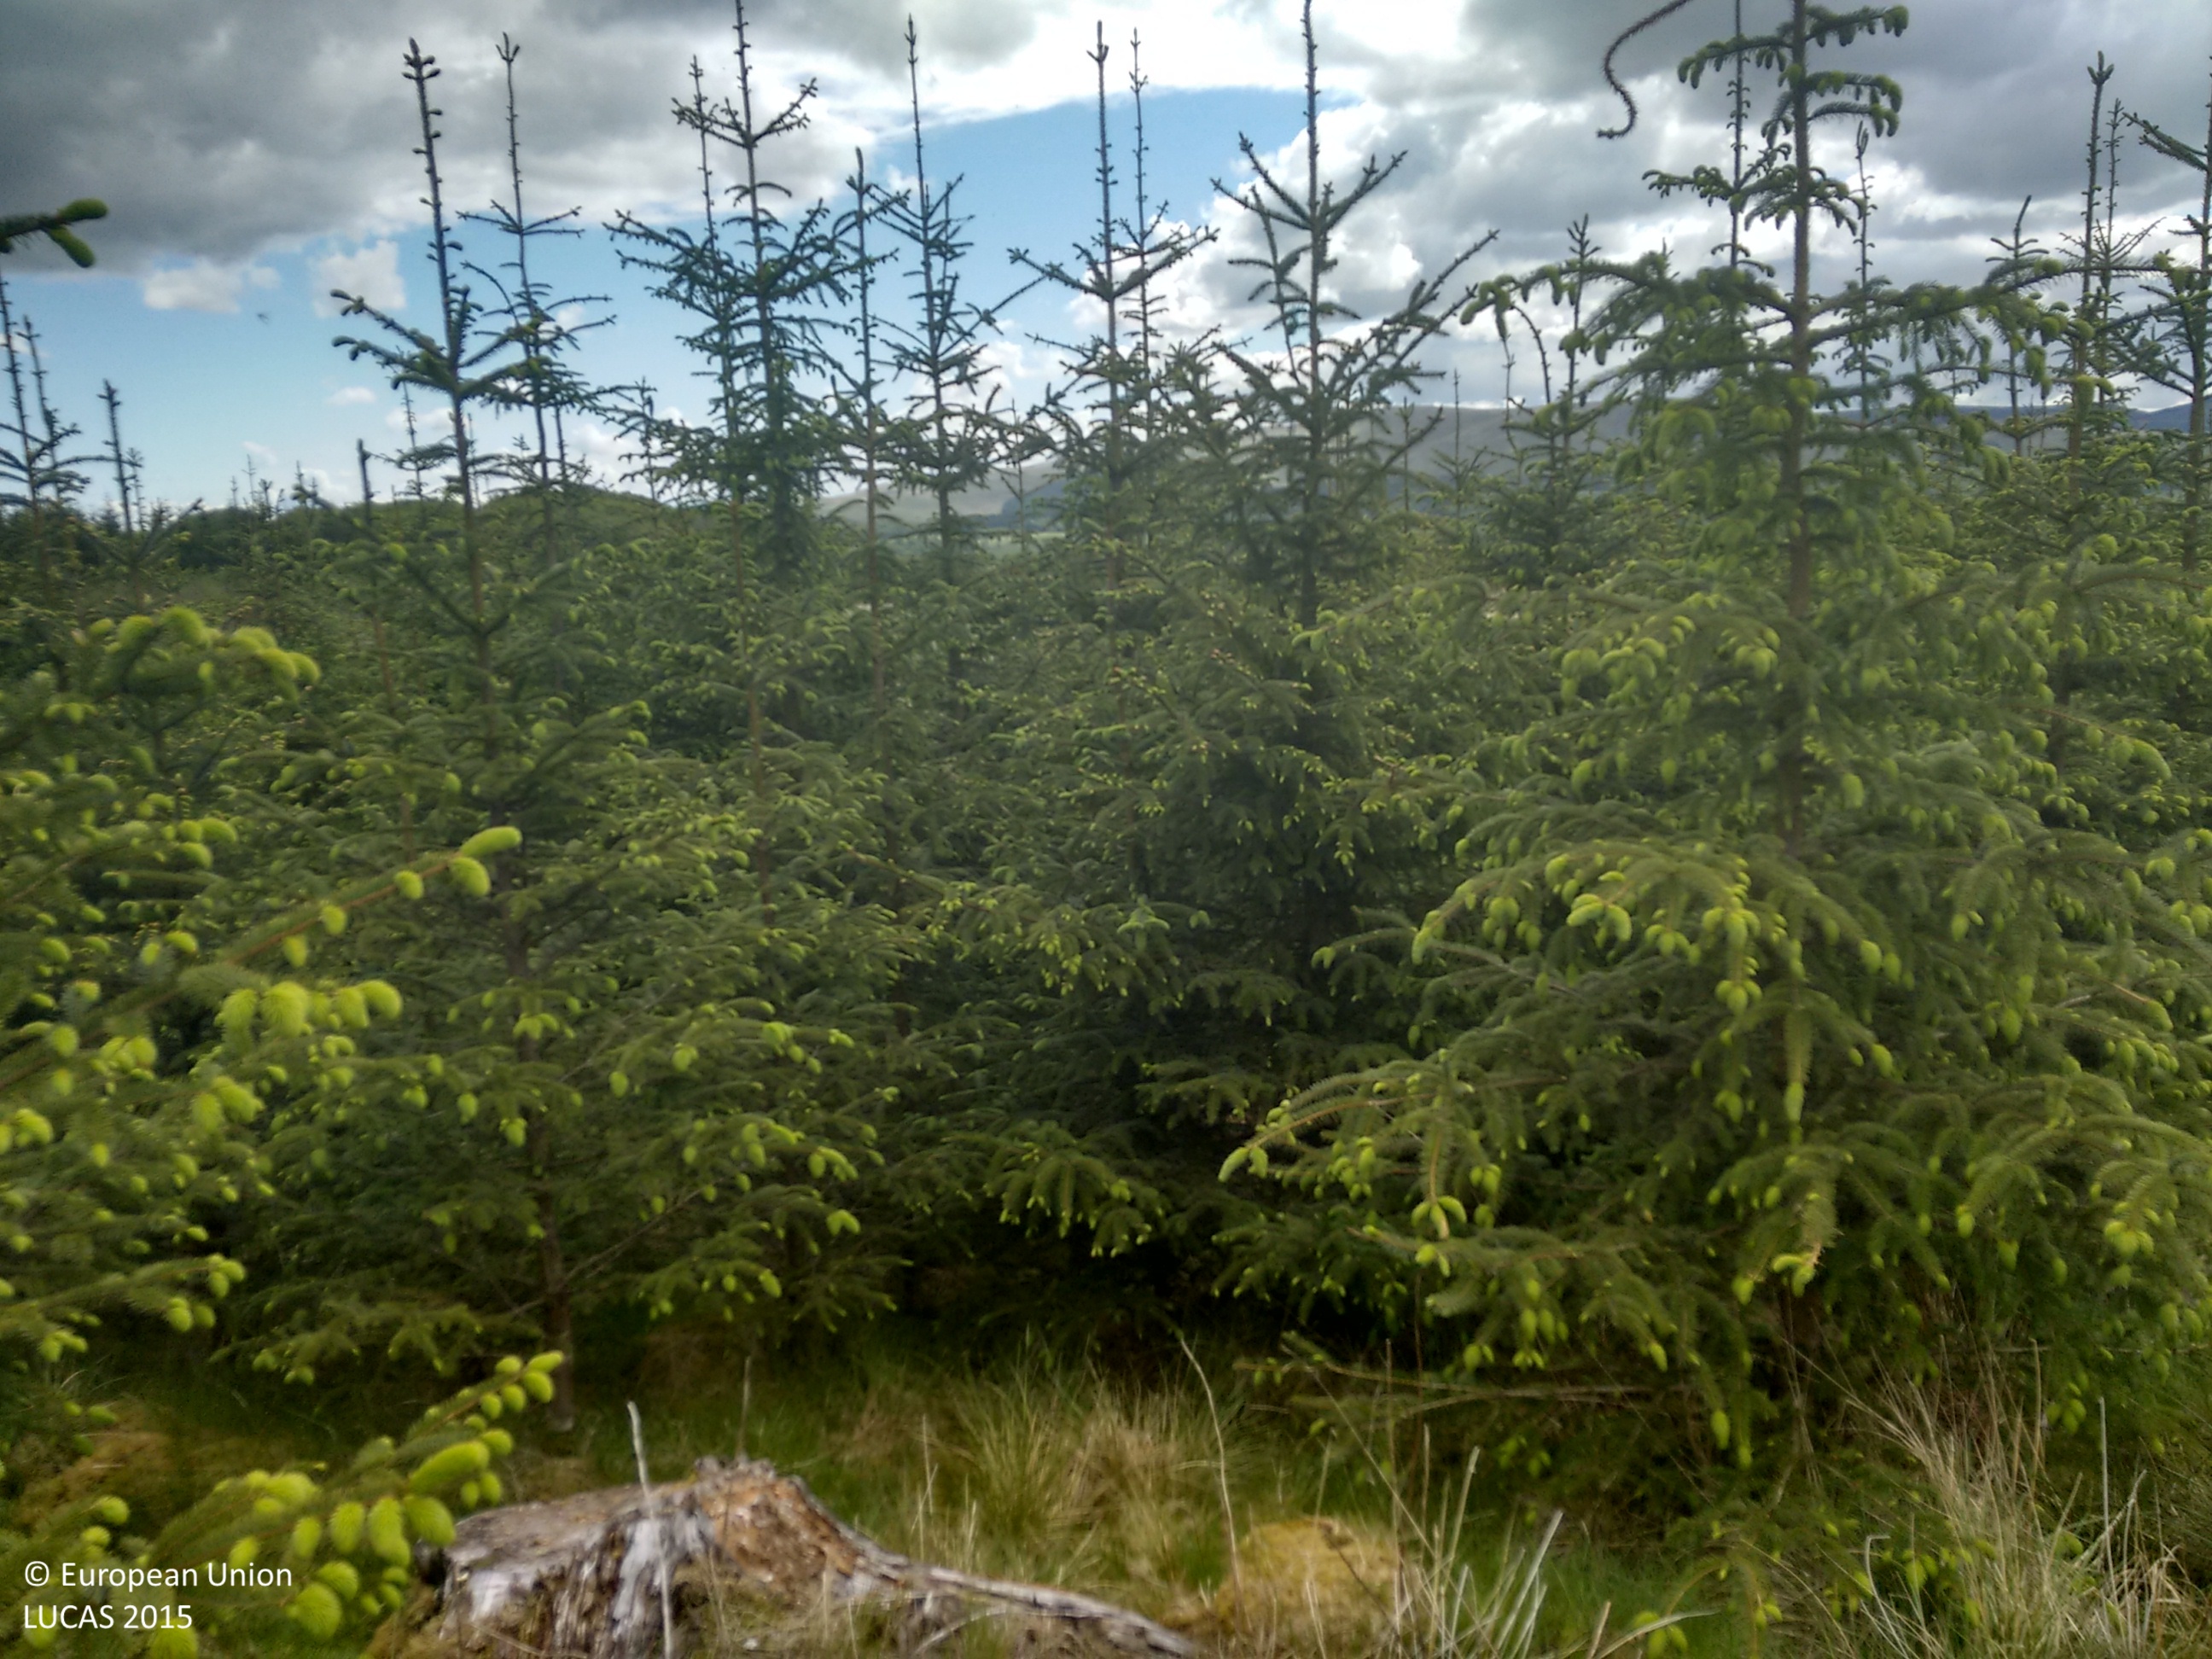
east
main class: Woodland
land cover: Spruce dominated coniferous woodland
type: exotic forest
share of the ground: > 75 %
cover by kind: coniferous forest trees 85 %, herbaceous plants 15 %
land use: Forestry
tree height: < 5 m
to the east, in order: Spruce dominated coniferous woodland; Spontaneously vegetated surfaces; Ditches and canals; Spontaneously vegetated surfaces; Ditches and canals; Grass margins; Tracks; Grass margins; Ditches and canals; Fences; Grassland without tree/shrub cover
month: June
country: GB
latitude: 55.7345
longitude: -3.2438
